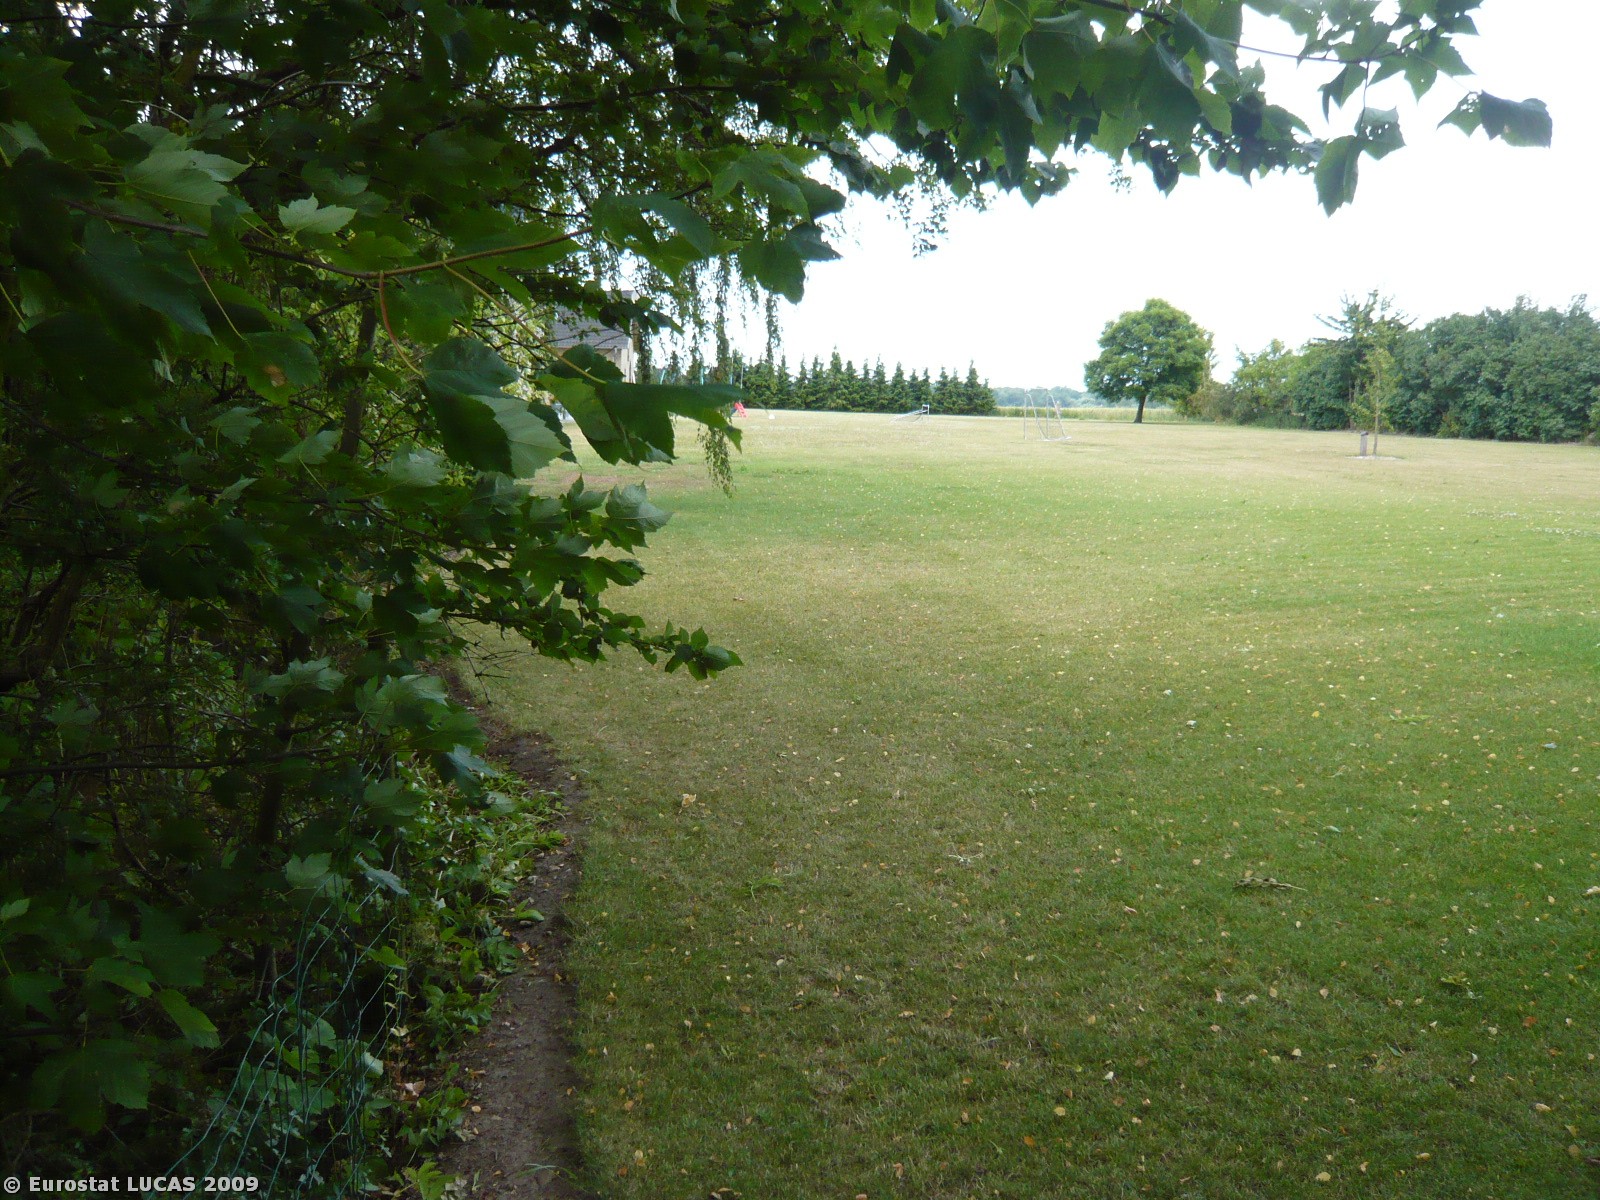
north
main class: Grassland
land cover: Grassland without tree/shrub cover
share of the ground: > 75 %
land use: Residential
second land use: Sport
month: July
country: DK
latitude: 55.5405
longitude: 10.1741
